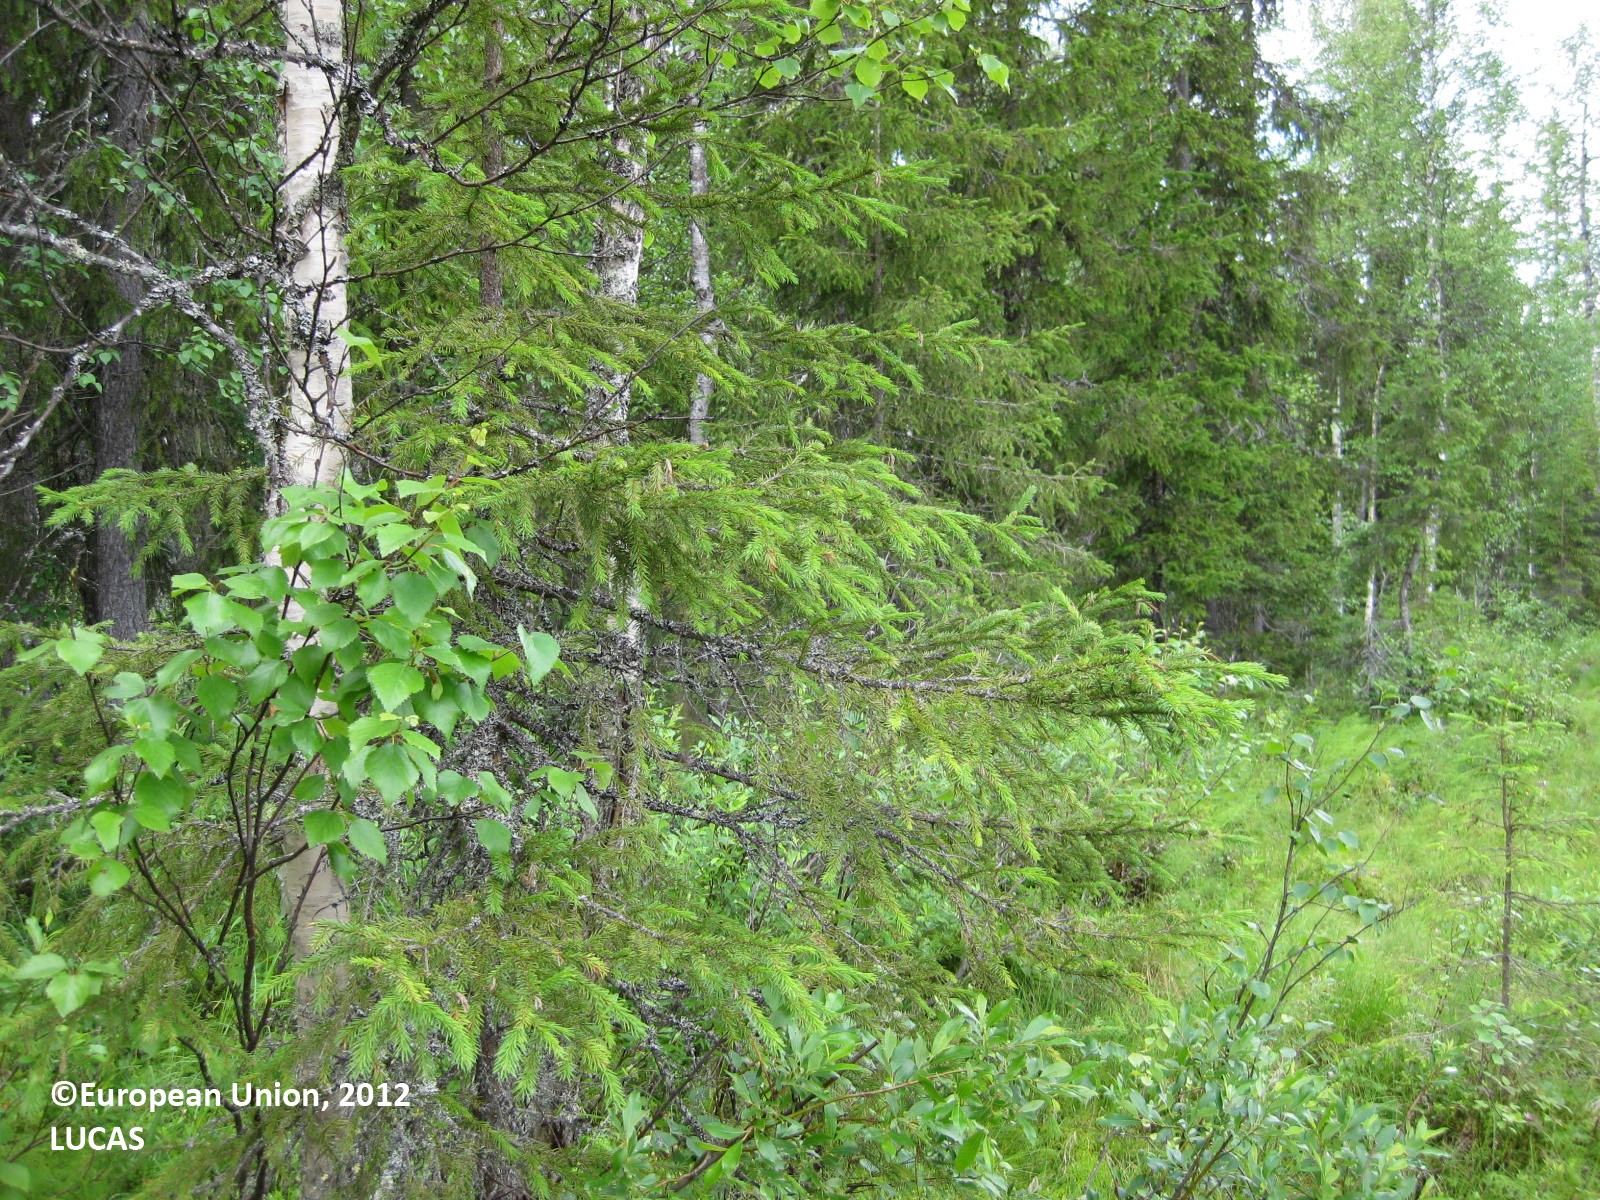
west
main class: Woodland
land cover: Spruce dominated mixed woodland
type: boreal forest
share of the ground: 50 - 75 %
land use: Forestry
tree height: < 5 m
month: July
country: FI
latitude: 65.5617
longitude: 28.2847
